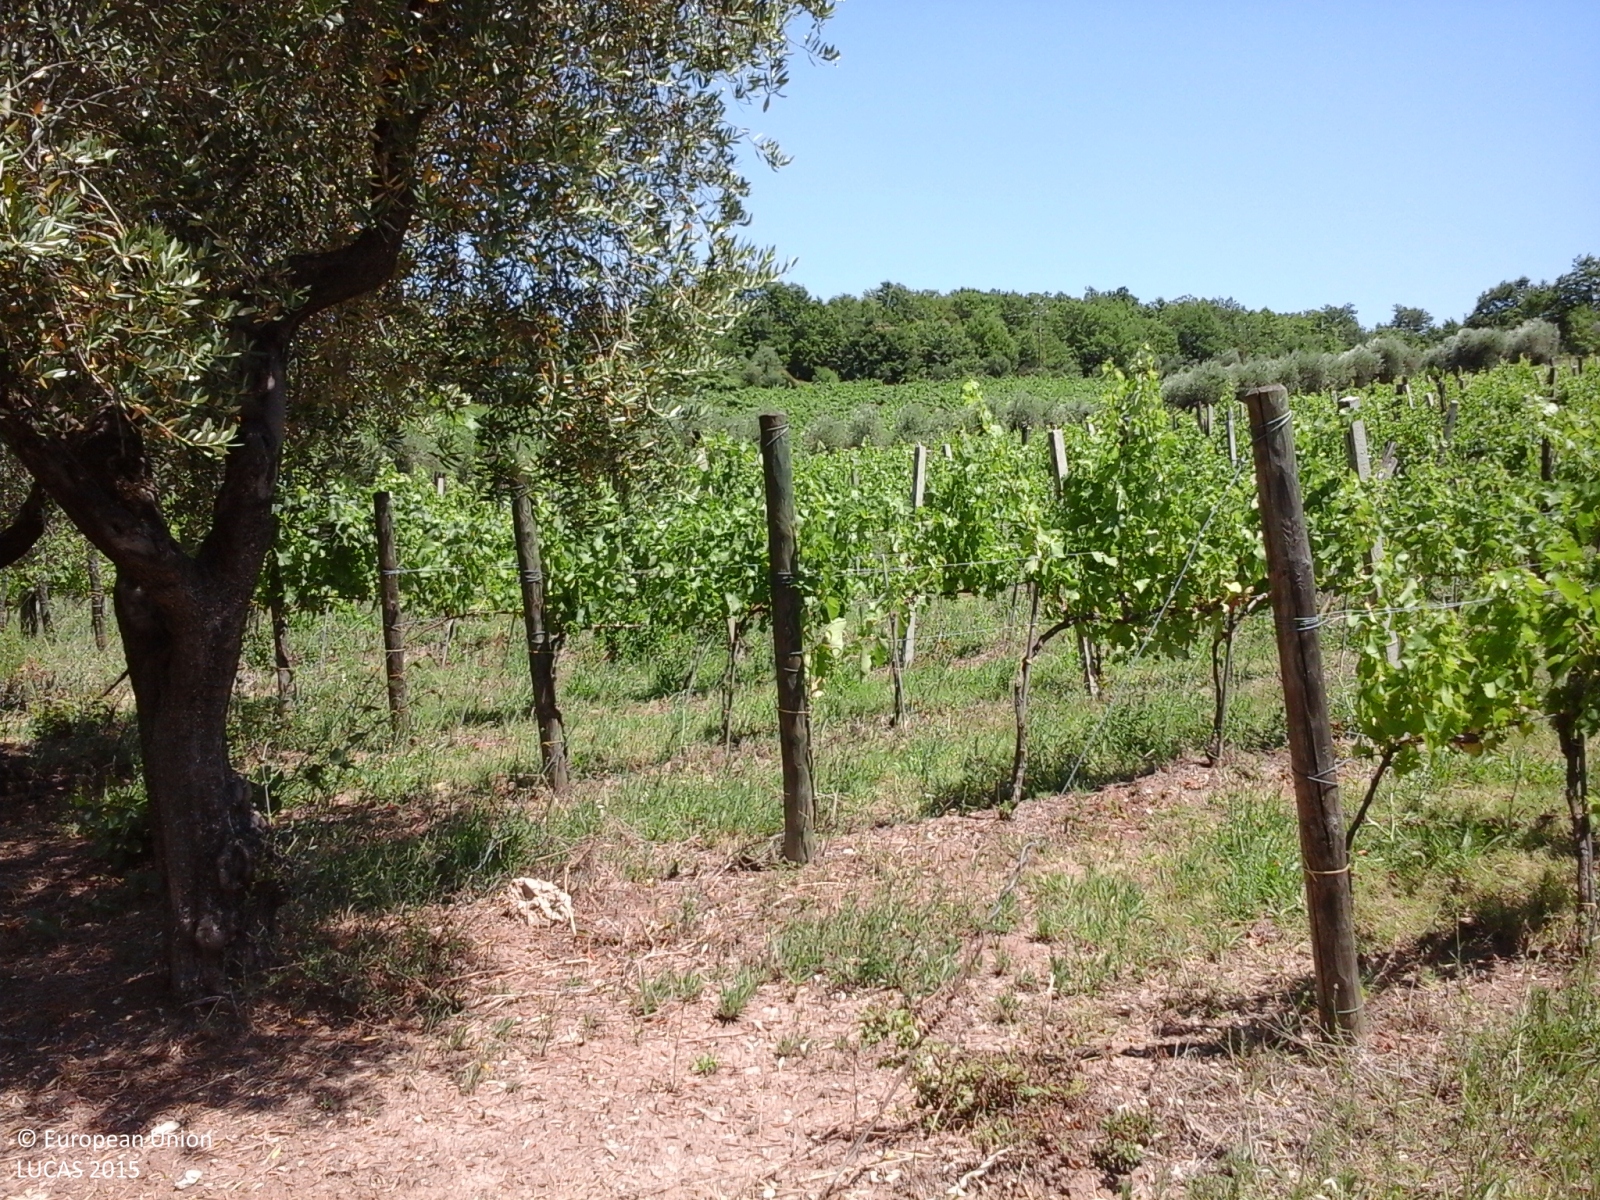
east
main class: Cropland
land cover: Olive groves
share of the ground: 25 - 50 %
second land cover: Spontaneously vegetated surfaces
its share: > 75 %
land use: Agriculture (excluding fallow land and kitchen gardens)
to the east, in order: Olive groves; Spontaneously vegetated surfaces; Vineyards; Olive groves; Vineyards; Electric lines; Abandoned hedges; Paved roads, cycling and walking lanes; Broadleaved woodland; Lucerne; Electric lines; Lucerne; Broadleaved woodland
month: July
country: IT
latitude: 41.7133
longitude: 14.6837
